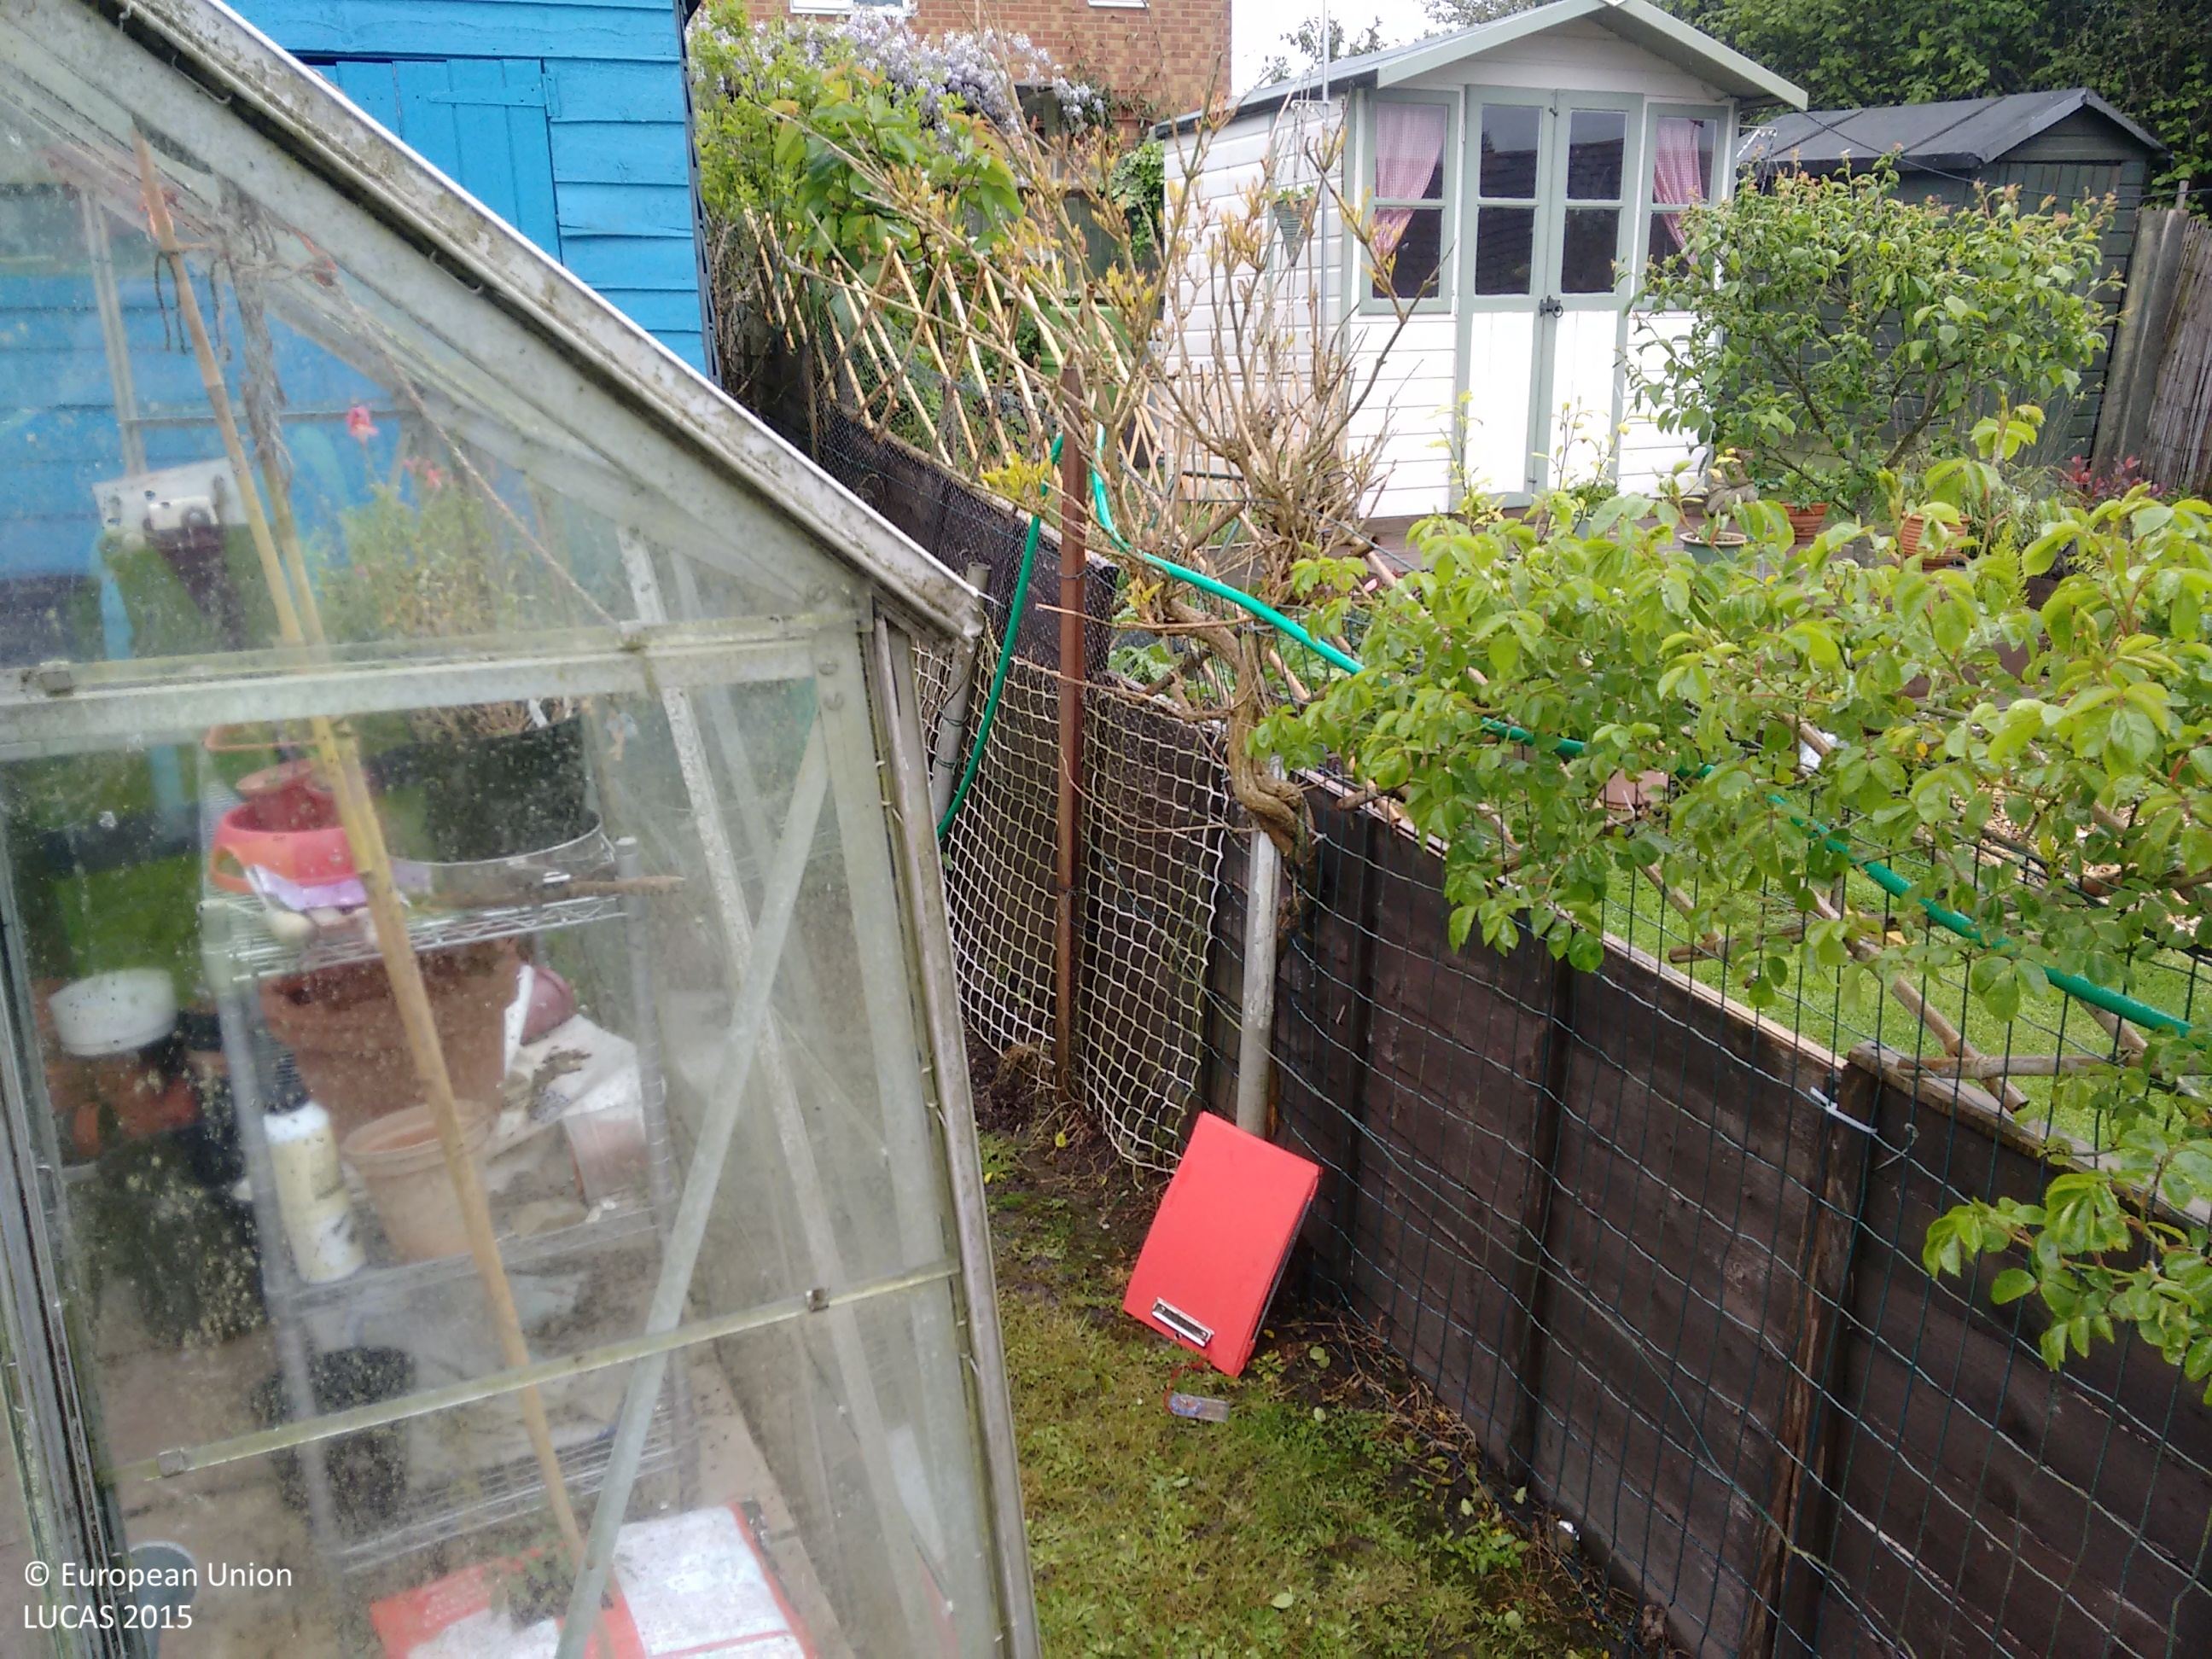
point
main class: Grassland
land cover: Grassland without tree/shrub cover
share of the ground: > 75 %
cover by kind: herbaceous plants 85 %, consolidated bare surface 10 %, shrubs 5 %
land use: Residential
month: May
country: GB
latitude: 50.9987
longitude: -0.9444
